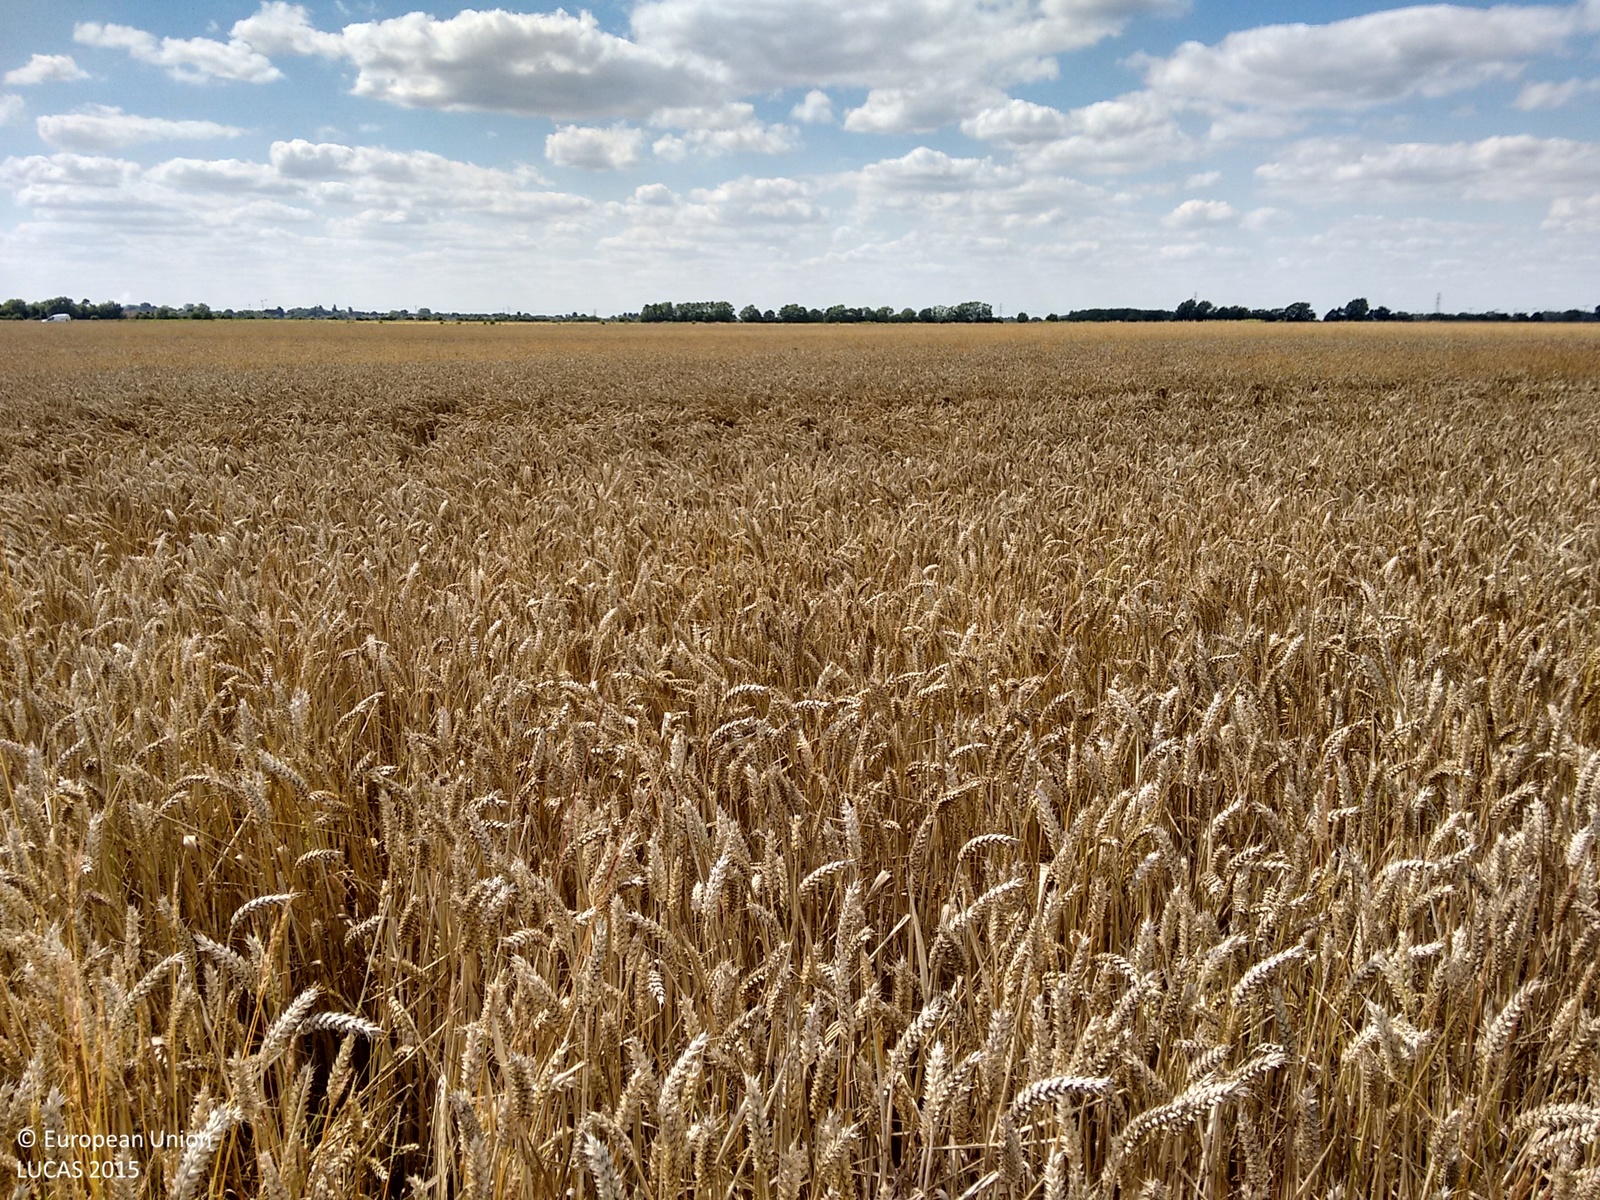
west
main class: Cropland
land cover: Common wheat
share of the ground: > 75 %
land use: Agriculture (excluding fallow land and kitchen gardens)
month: July
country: GB
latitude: 52.7649
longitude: 0.3829
